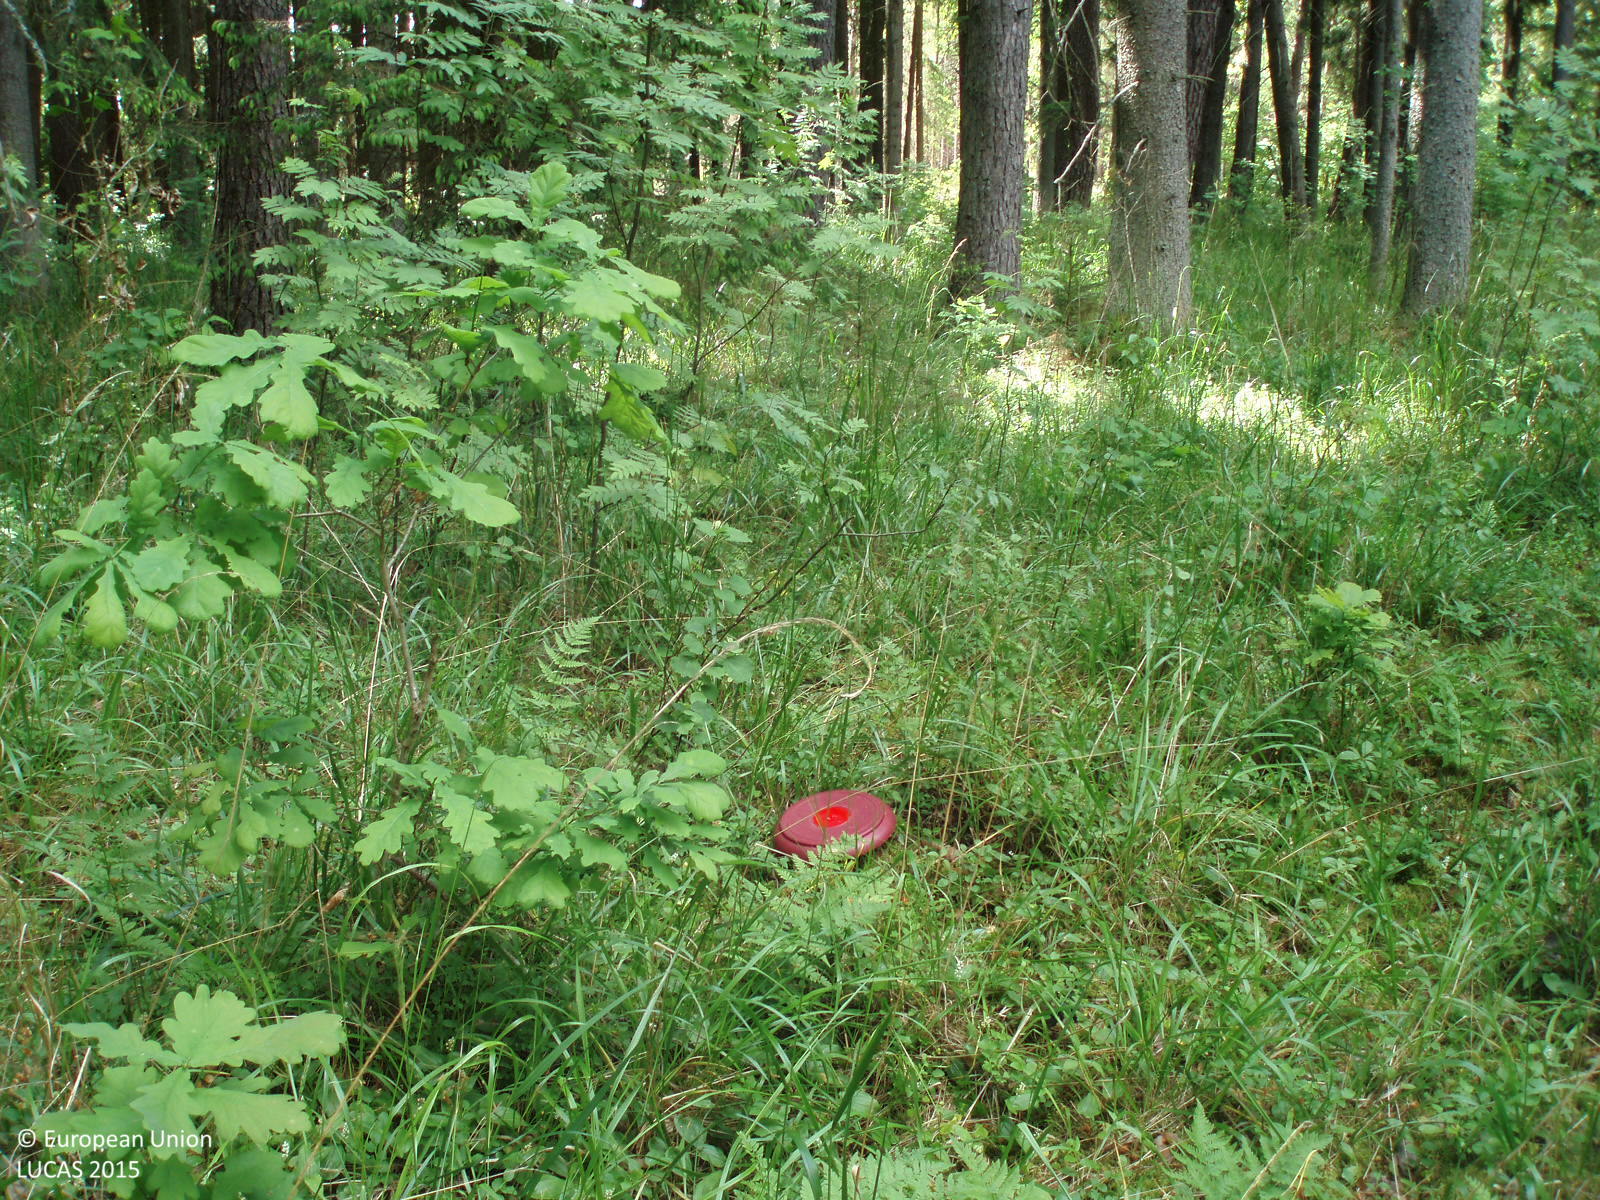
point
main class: Woodland
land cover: Other coniferous woodland
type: hemiboreal forest and nemoral coniferous forest and mixed broadleaved-coniferous forest
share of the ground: > 75 %
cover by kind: coniferous forest trees 70 %, herbaceous plants 20 %, broadleaved forest trees 10 %
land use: Forestry
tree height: > 5 m
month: June
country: LT
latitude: 55.0686
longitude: 22.4484
